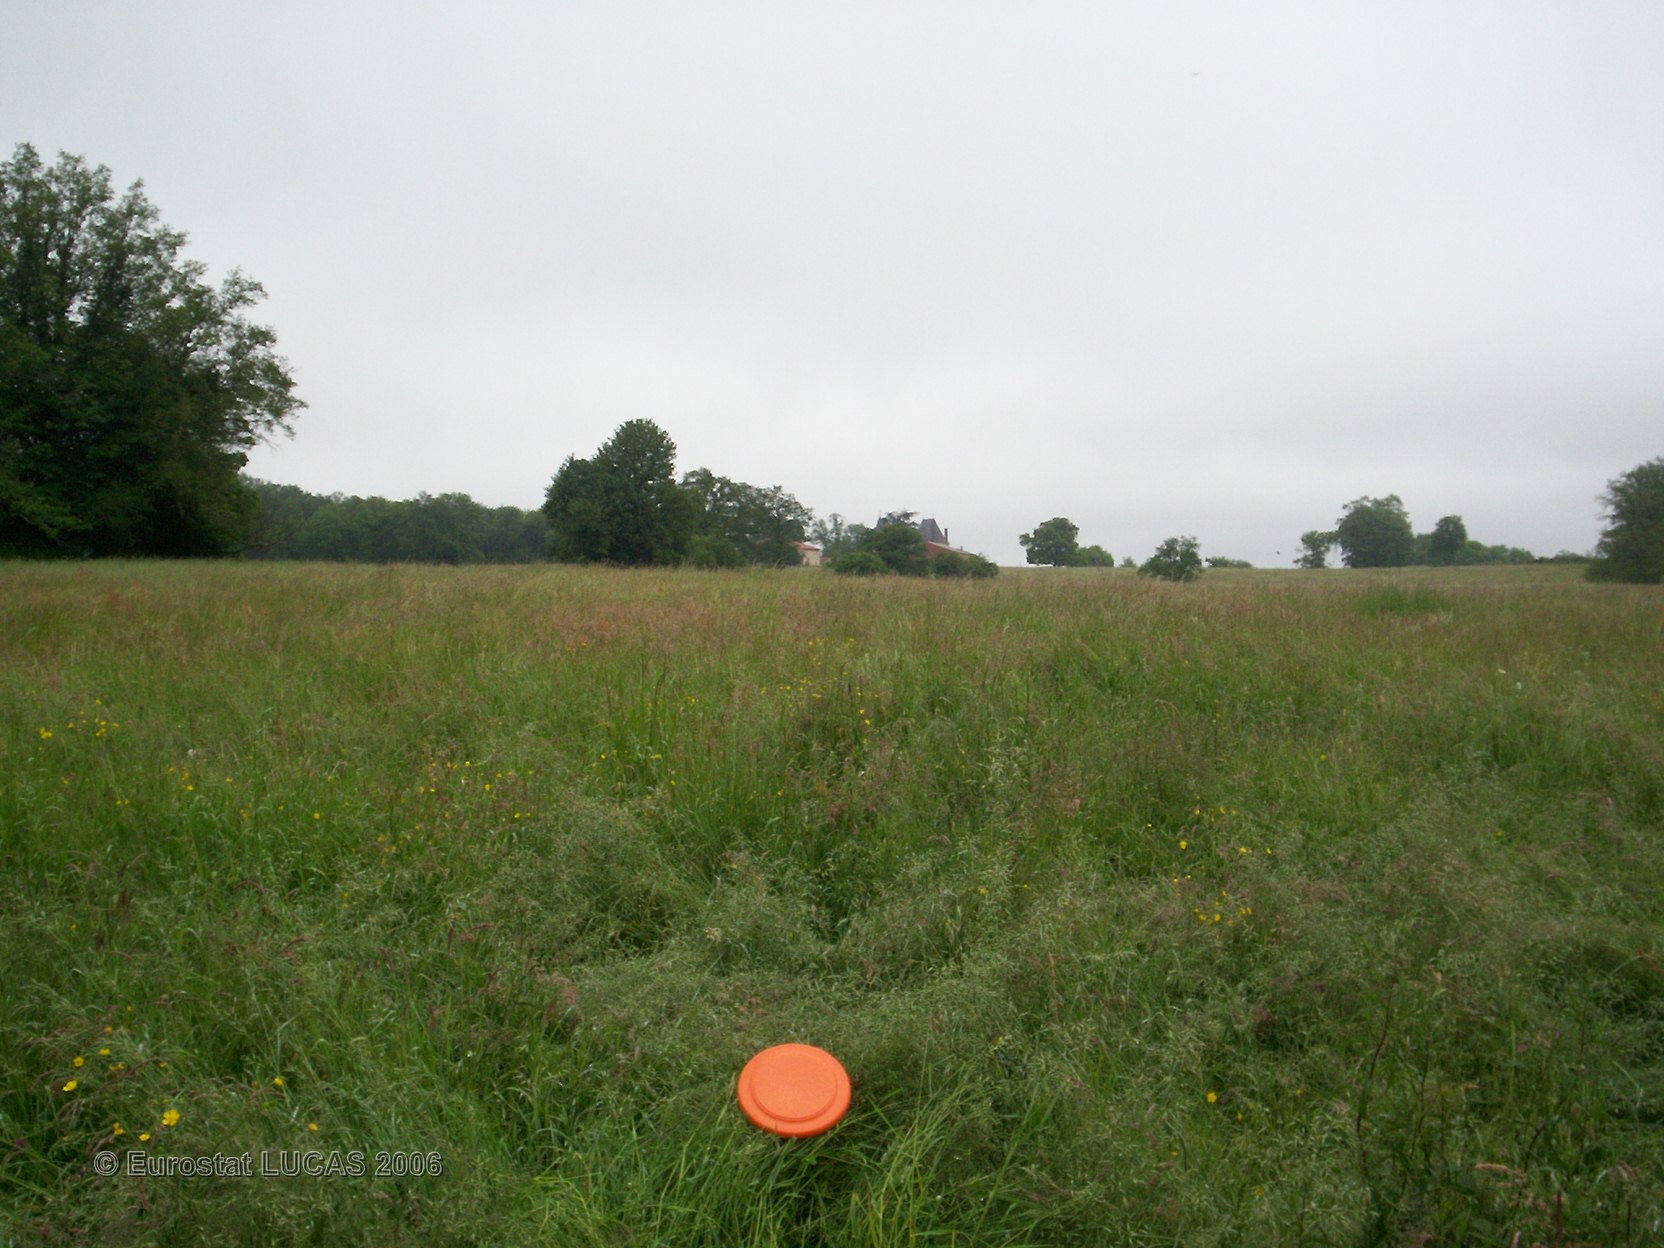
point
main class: Grassland
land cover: Grassland without tree/shrub cover
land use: Agriculture (excluding fallow land and kitchen gardens)
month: May
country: FR
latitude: 45.8213
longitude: 0.7330
